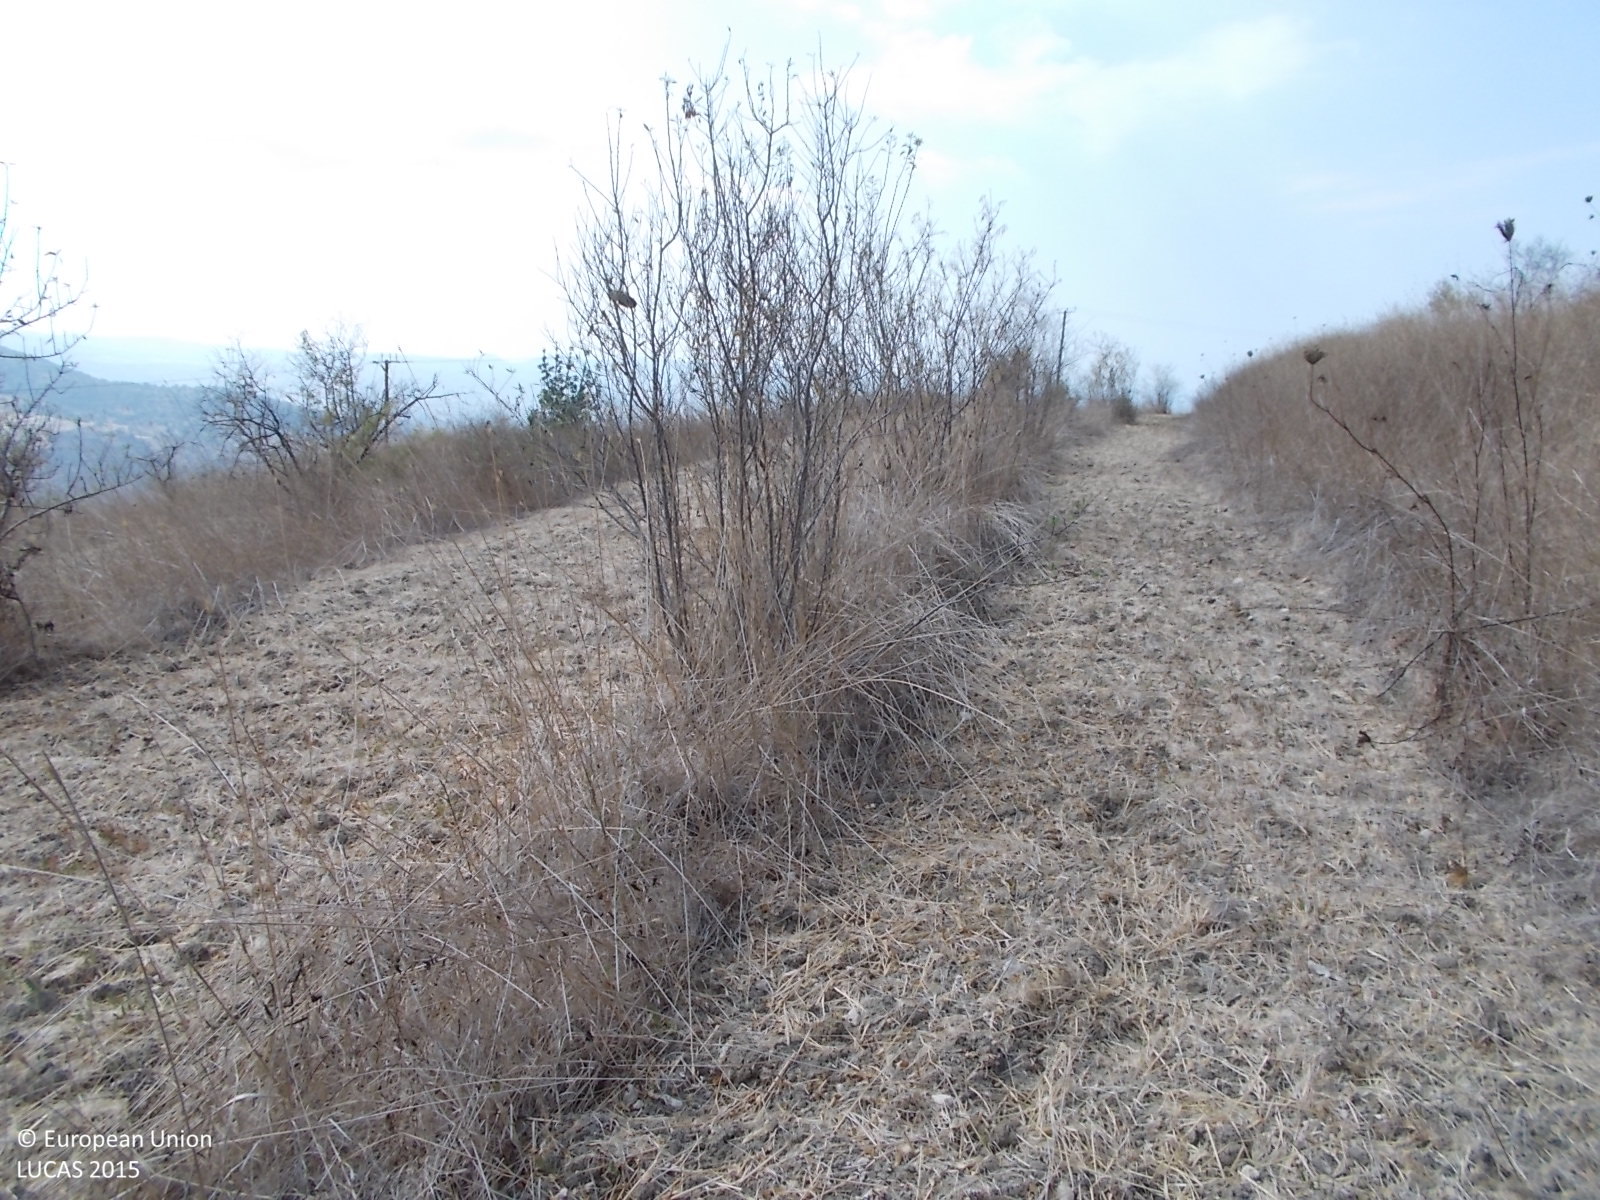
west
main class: Cropland
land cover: Nuts trees
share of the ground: 10 - 25 %
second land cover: Spontaneously vegetated surfaces
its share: 25 - 50 %
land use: Agriculture (excluding fallow land and kitchen gardens)
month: June
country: CY
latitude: 35.0313
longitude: 32.5055
